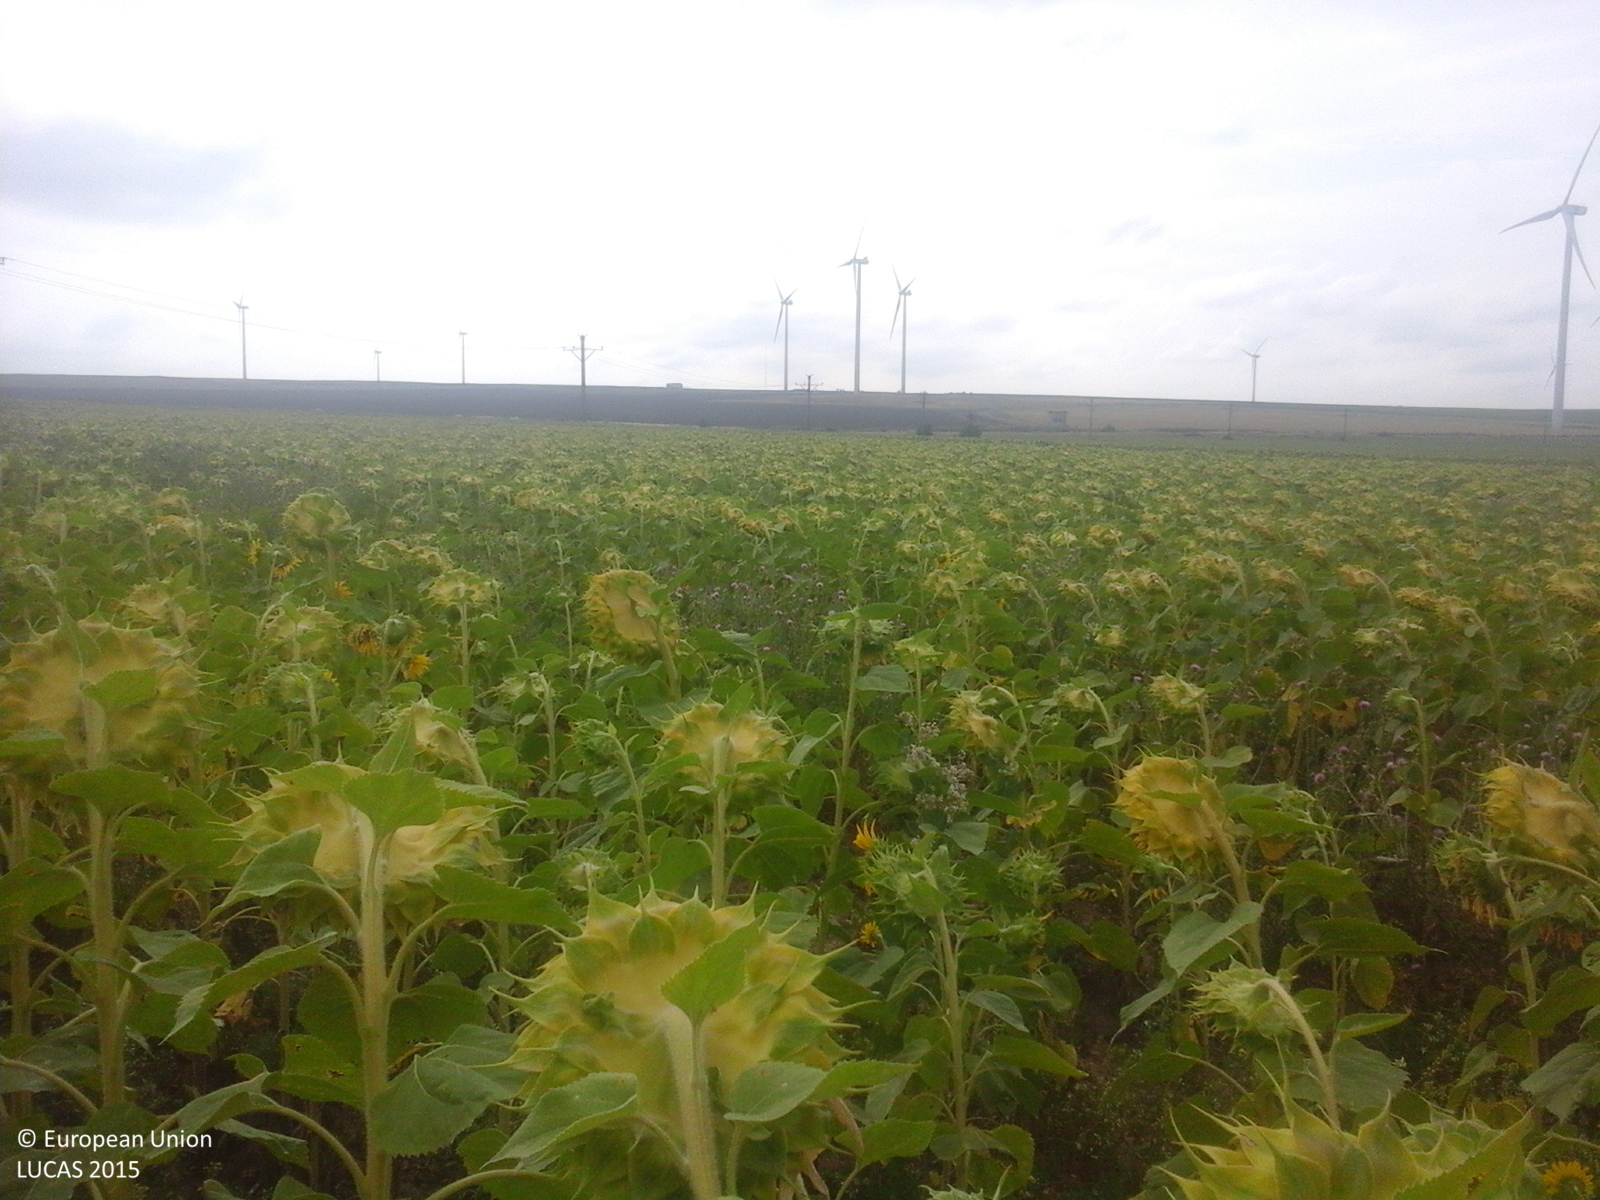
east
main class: Cropland
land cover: Sunflower
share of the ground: > 75 %
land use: Agriculture (excluding fallow land and kitchen gardens)
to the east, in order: Sunflower; Electric lines; Sunflower; Grass margins; Ditches and canals; Shruby margins; Tracks; Grass margins; Common wheat; Grass margins; Common wheat
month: August
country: RO
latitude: 44.7857
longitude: 28.3337
